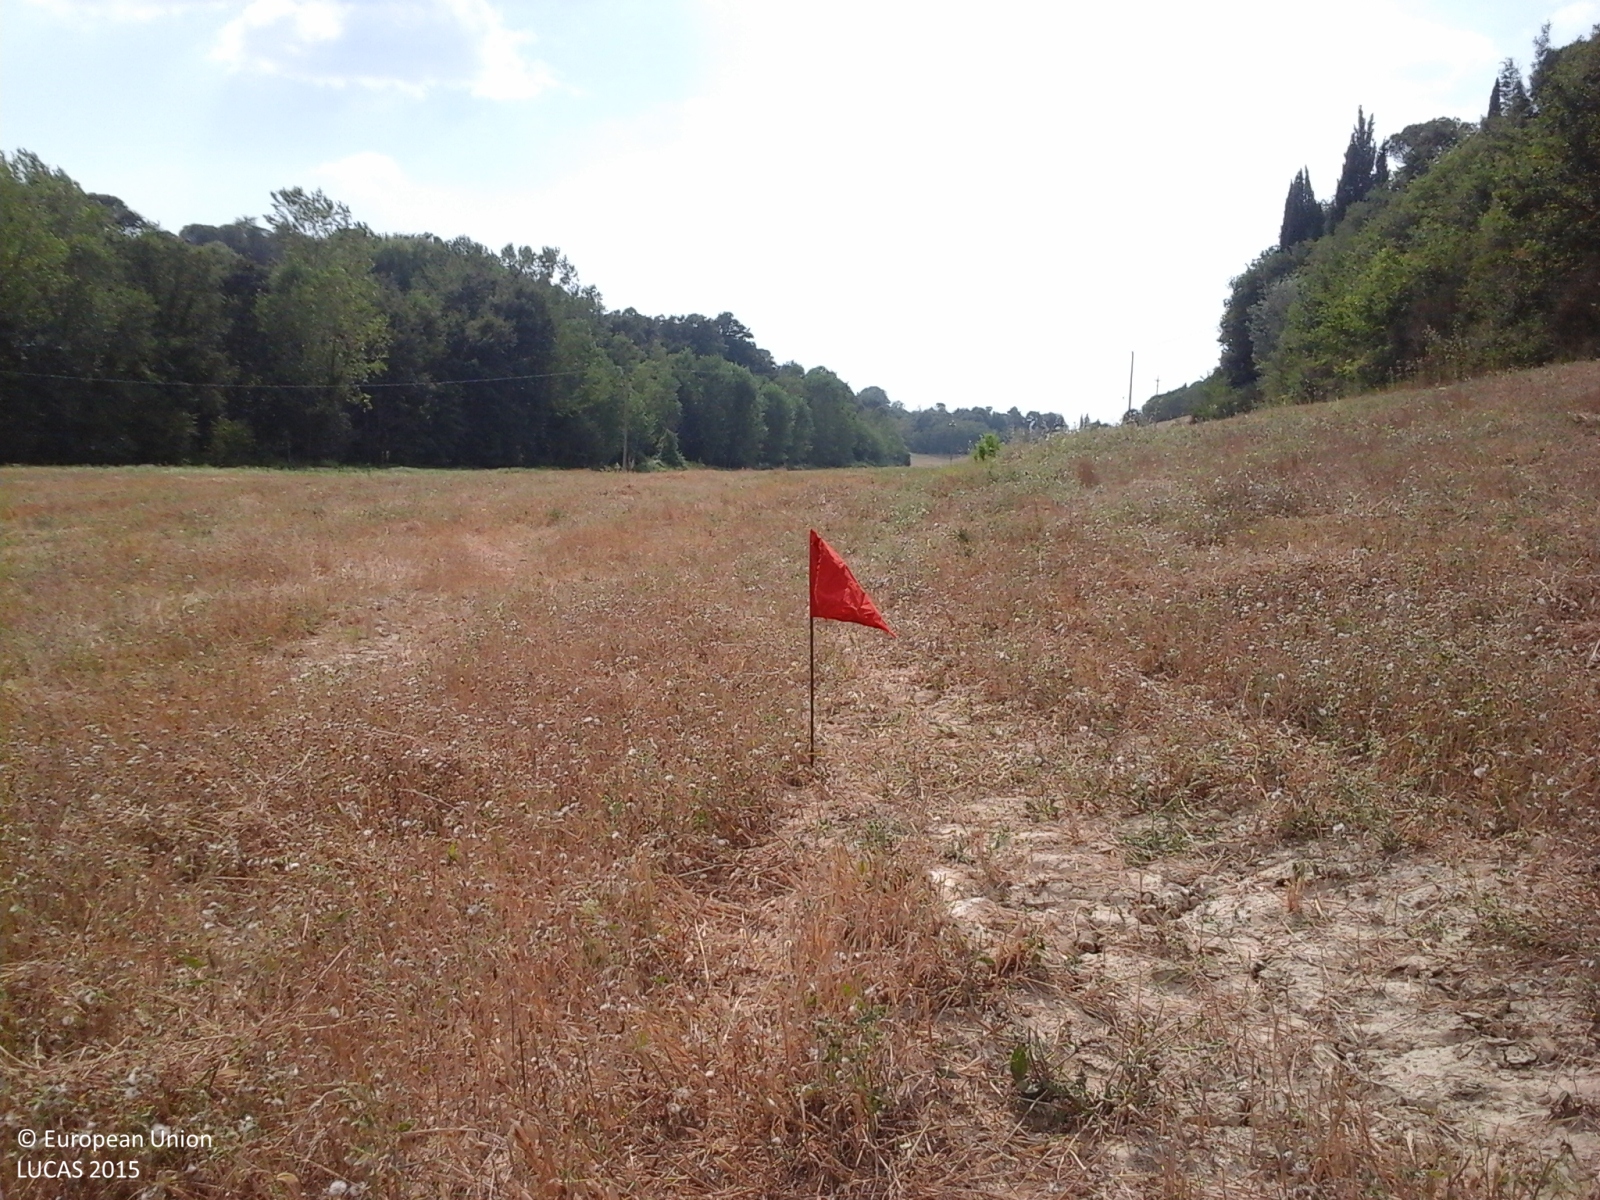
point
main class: Cropland
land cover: Mixed cereals for fodder
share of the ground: > 75 %
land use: Agriculture (excluding fallow land and kitchen gardens)
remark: Harvested field
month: July
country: IT
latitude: 43.1474
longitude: 11.5815
